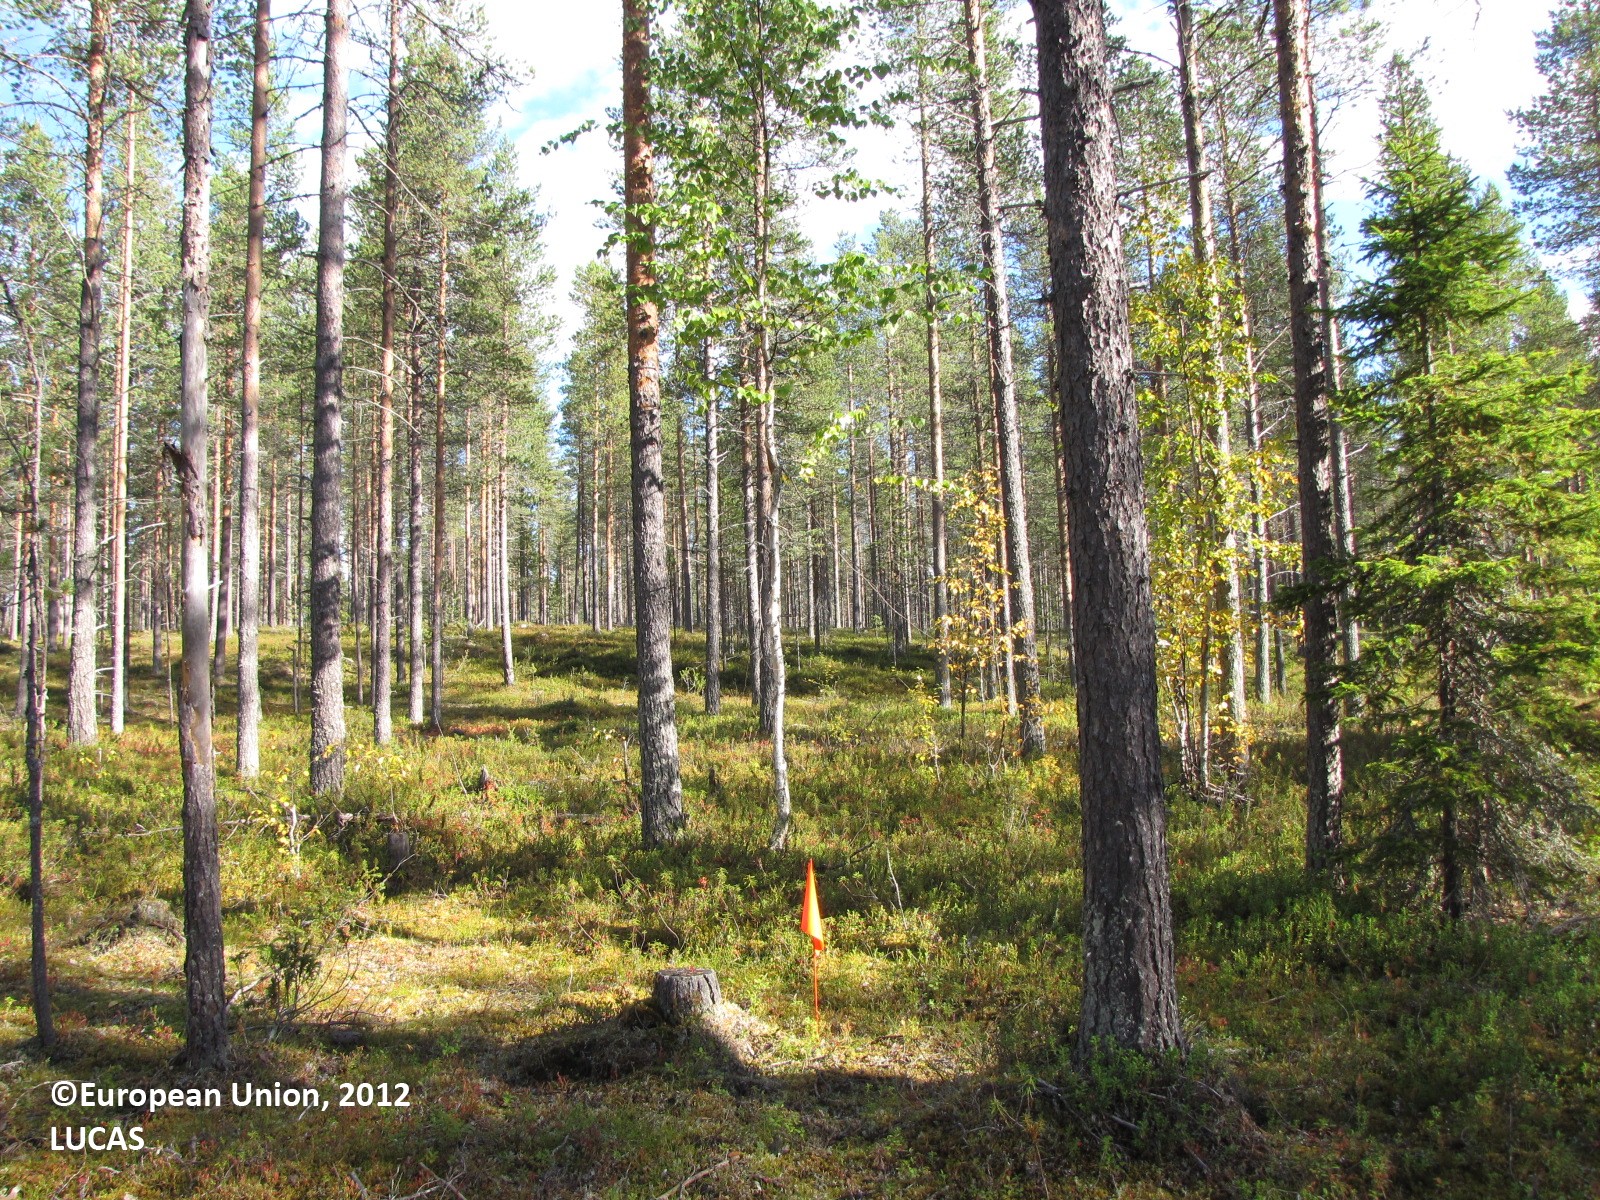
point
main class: Woodland
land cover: Pine dominated coniferous woodland
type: boreal forest
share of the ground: 25 - 50 %
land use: Forestry
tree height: > 5 m
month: September
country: FI
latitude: 67.2963
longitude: 24.8761
